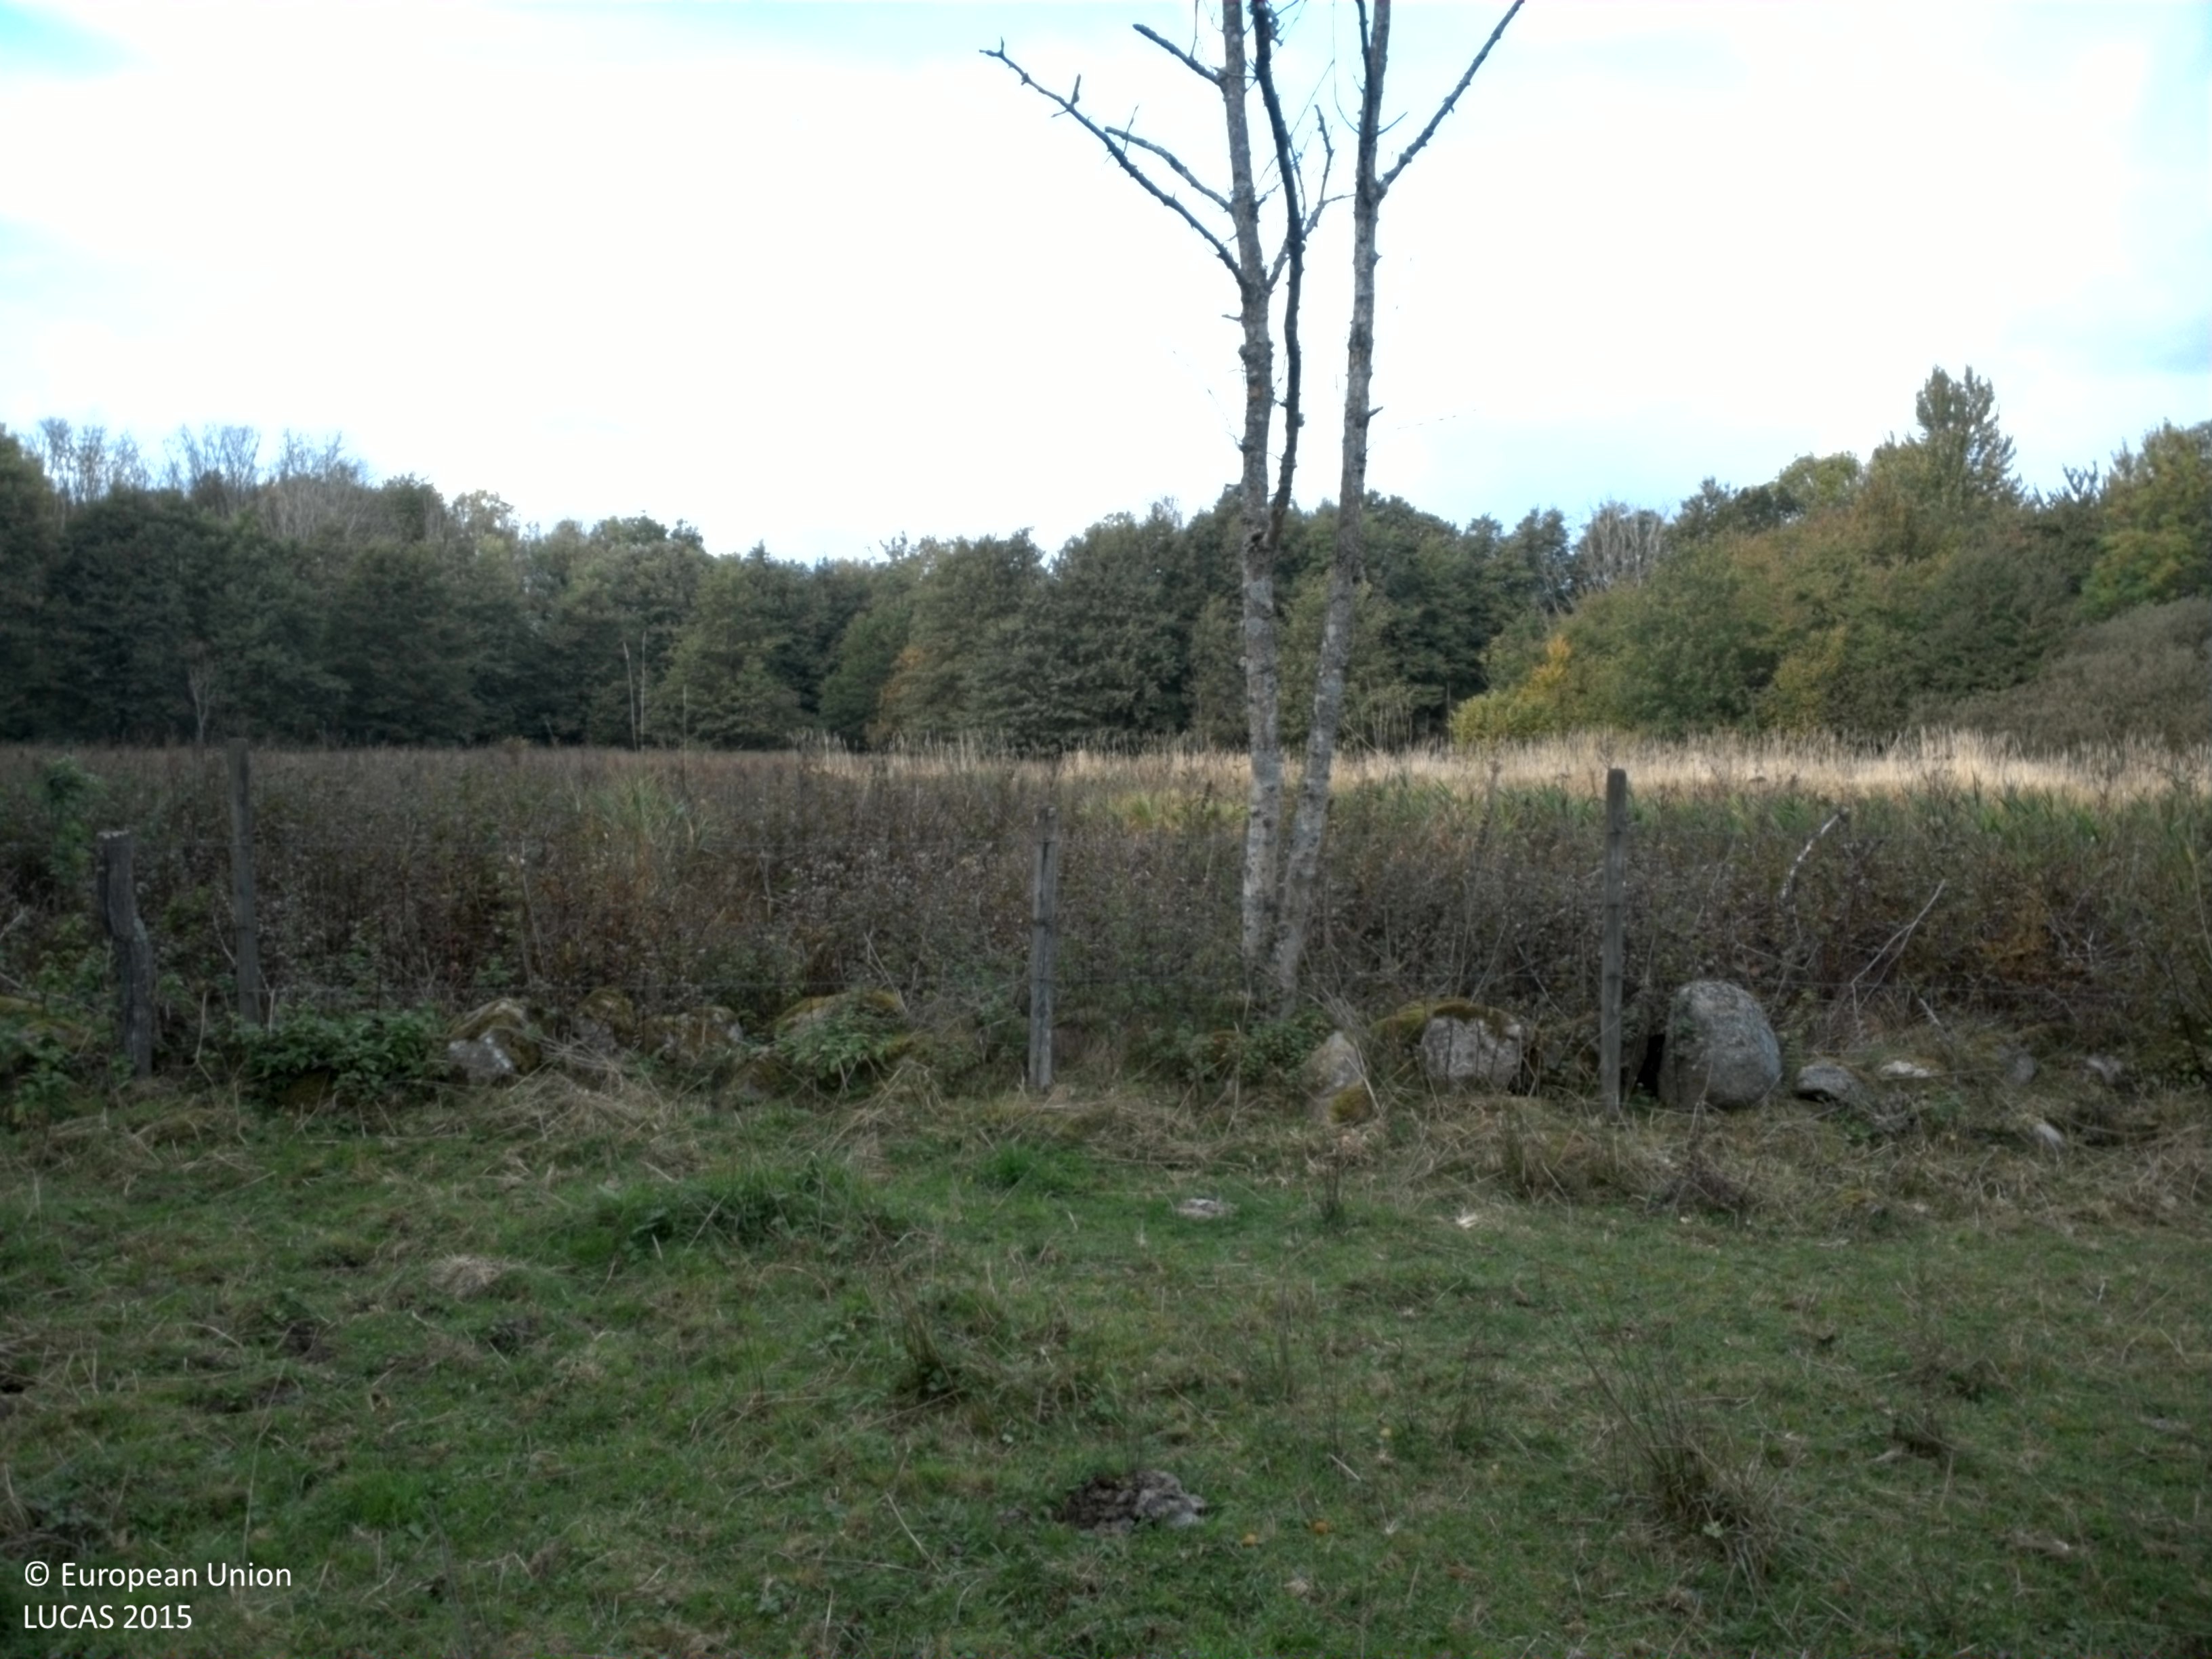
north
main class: Grassland
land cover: Grassland with sparse tree/shrub cover
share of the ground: > 75 %
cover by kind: herbaceous plants 90 %, broadleaved forest trees 5 %, consolidated bare surface 5 %
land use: Agriculture (excluding fallow land and kitchen gardens)
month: October
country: SE
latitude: 55.6507
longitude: 14.2098
